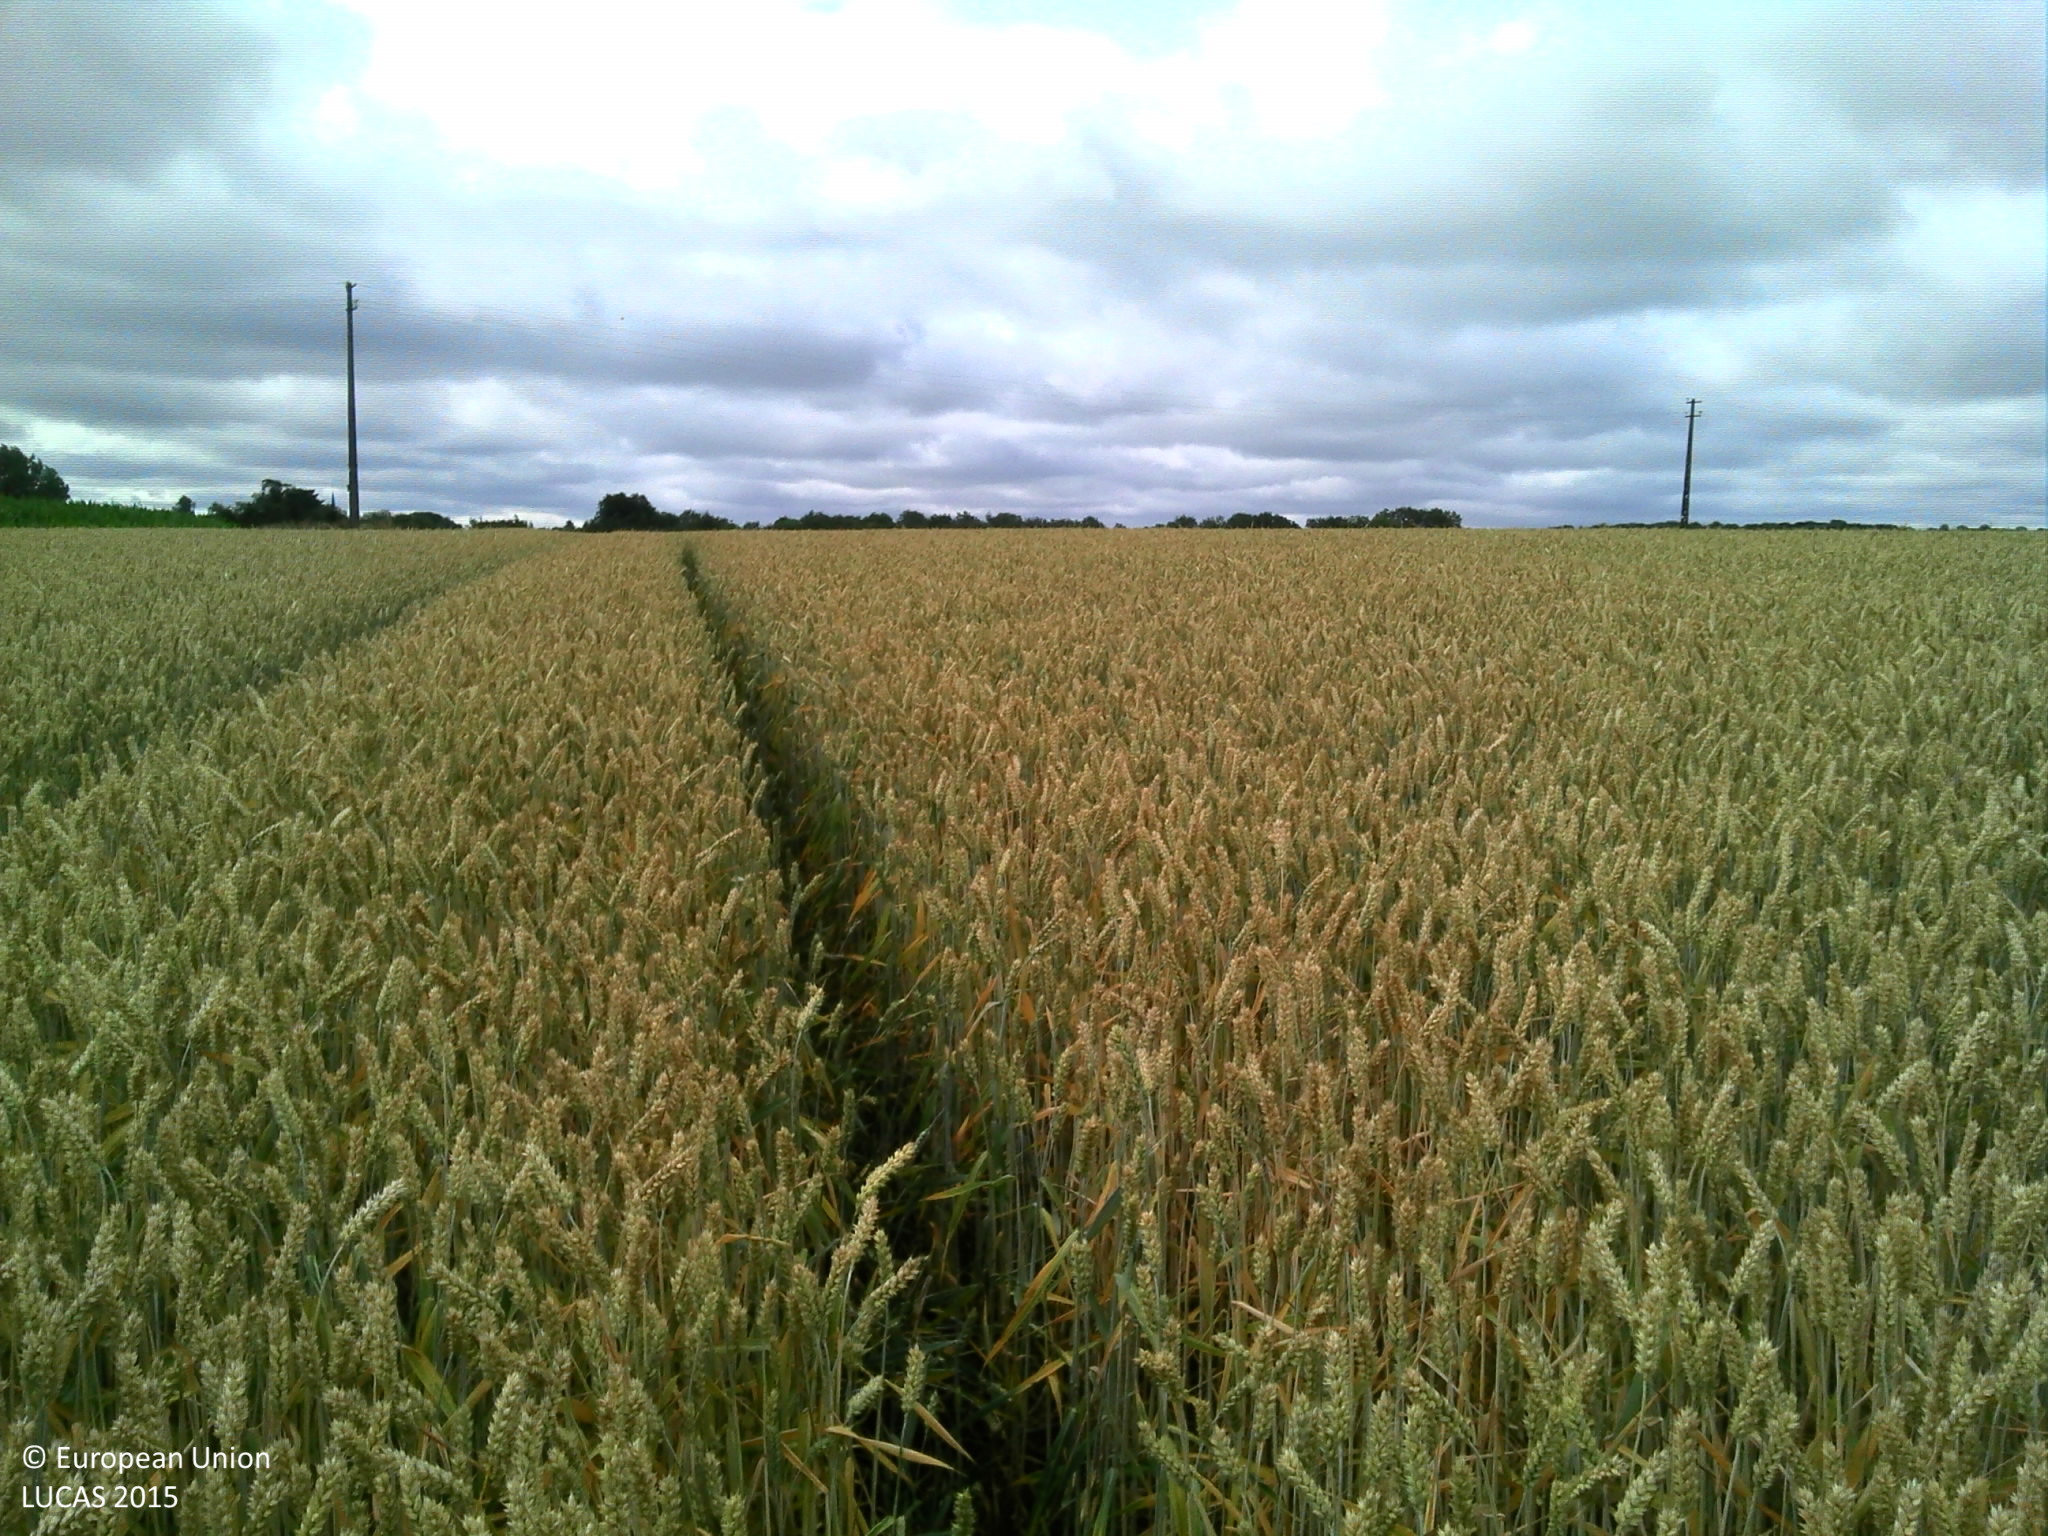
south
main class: Cropland
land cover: Common wheat
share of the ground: > 75 %
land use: Agriculture (excluding fallow land and kitchen gardens)
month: July
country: BE
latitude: 50.2404
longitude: 4.6823
